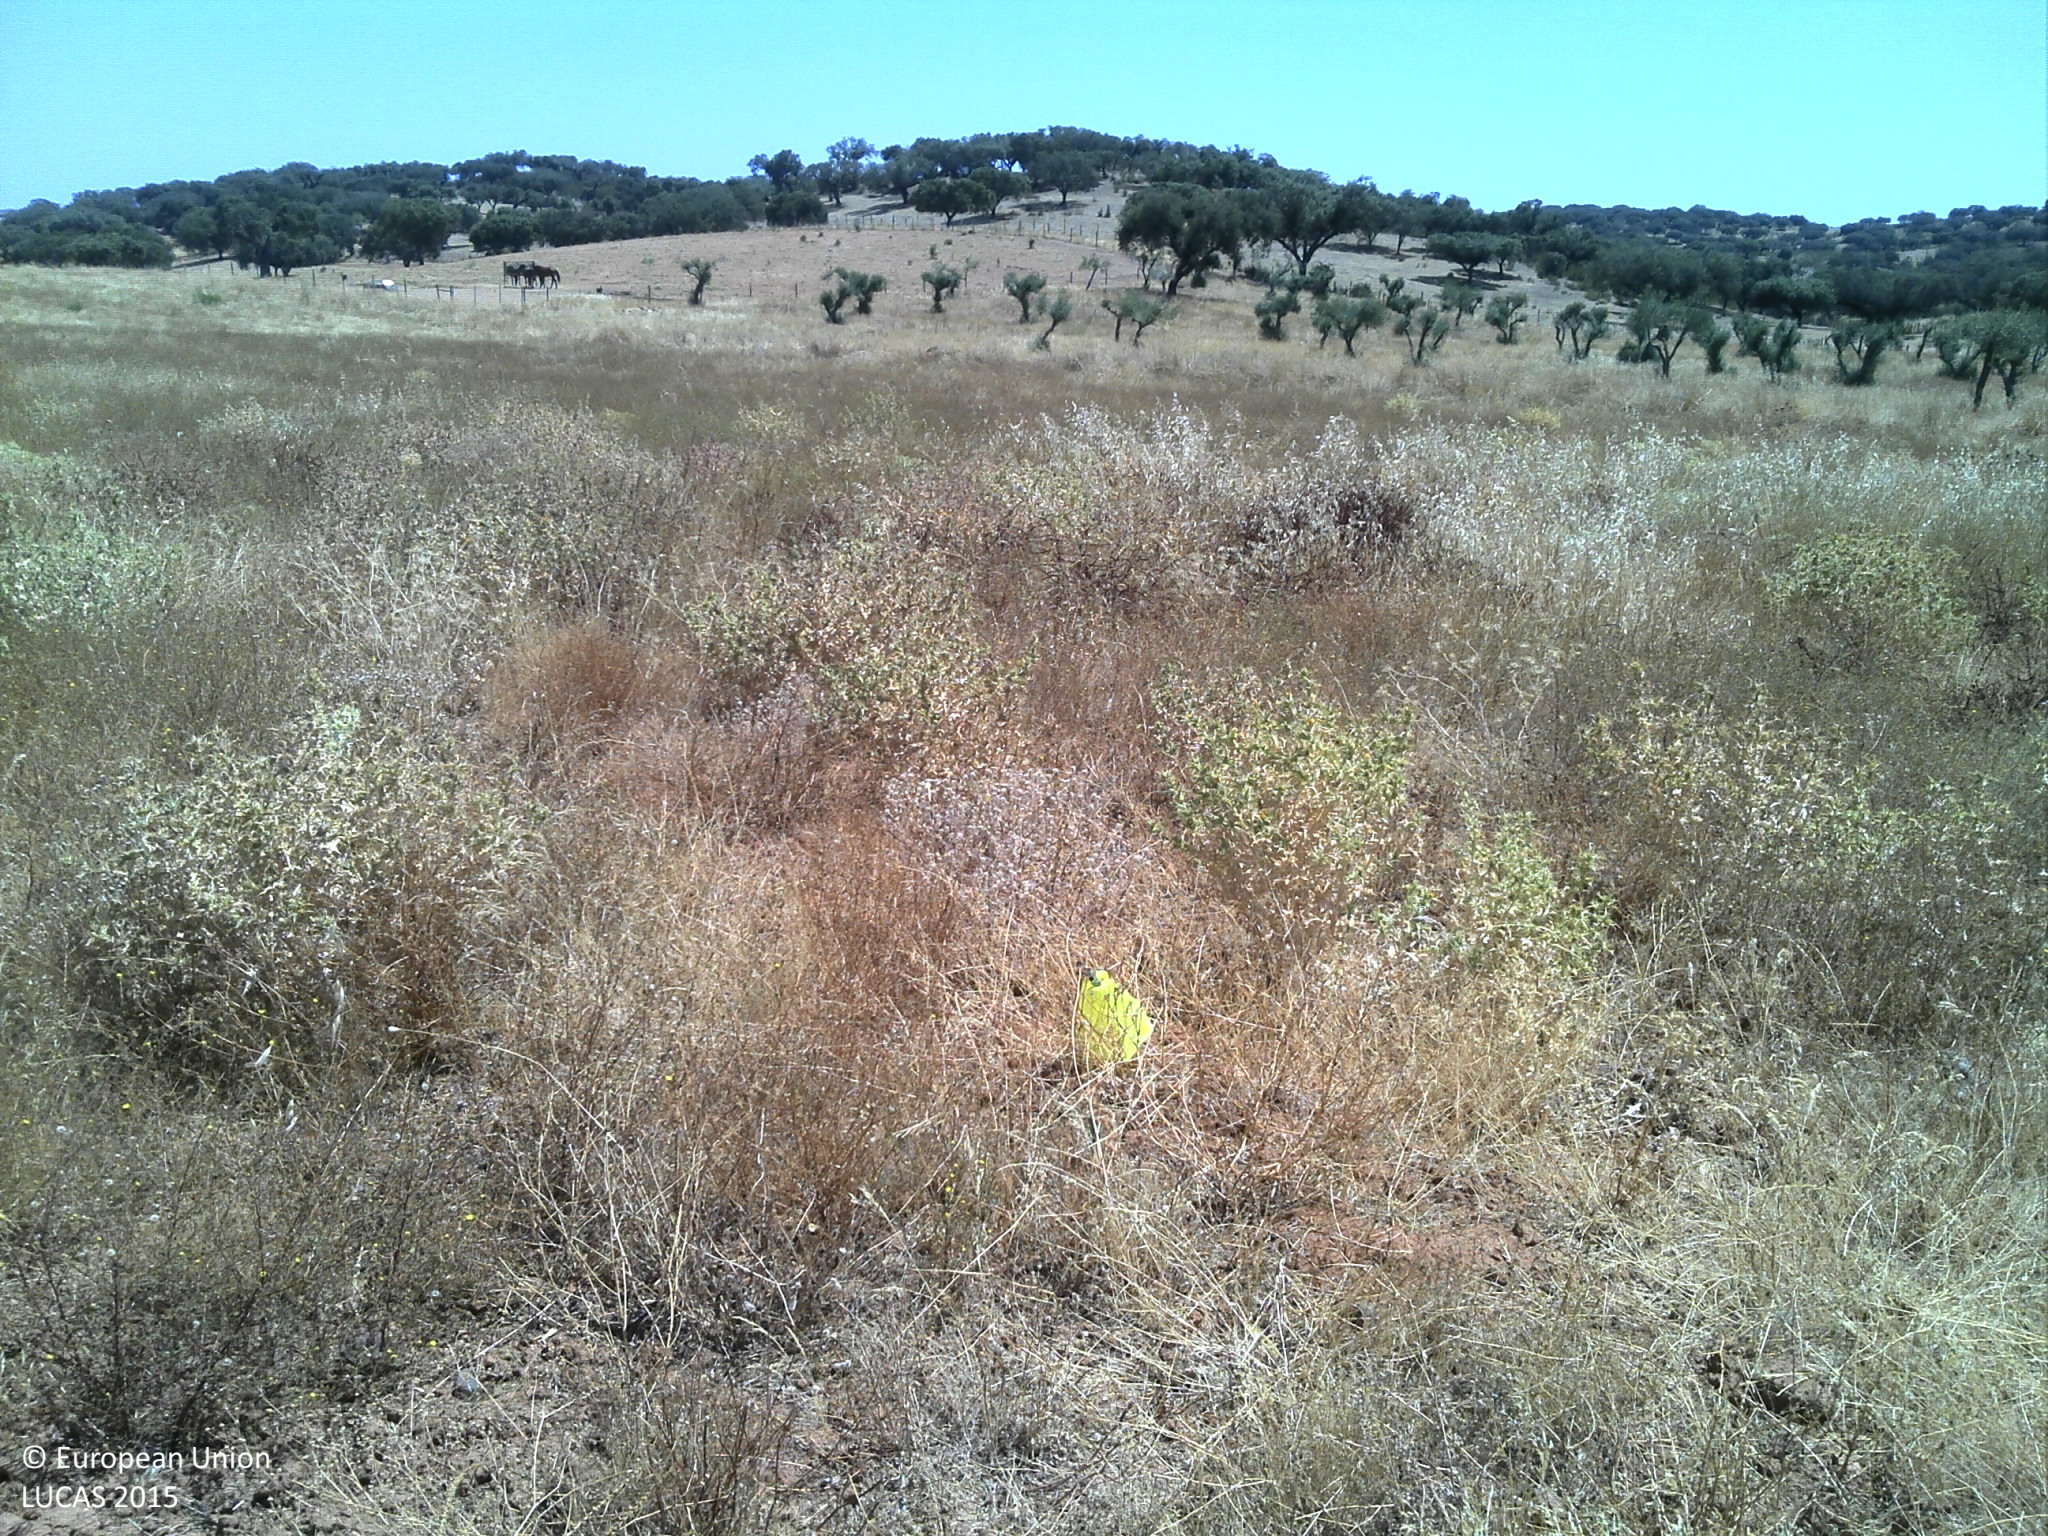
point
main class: Grassland
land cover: Grassland without tree/shrub cover
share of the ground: 25 - 50 %
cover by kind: unconsolidated bare surface 60 %, herbaceous plants 40 %
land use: Agriculture (excluding fallow land and kitchen gardens)
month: July
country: PT
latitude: 38.5480
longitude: -7.3167
